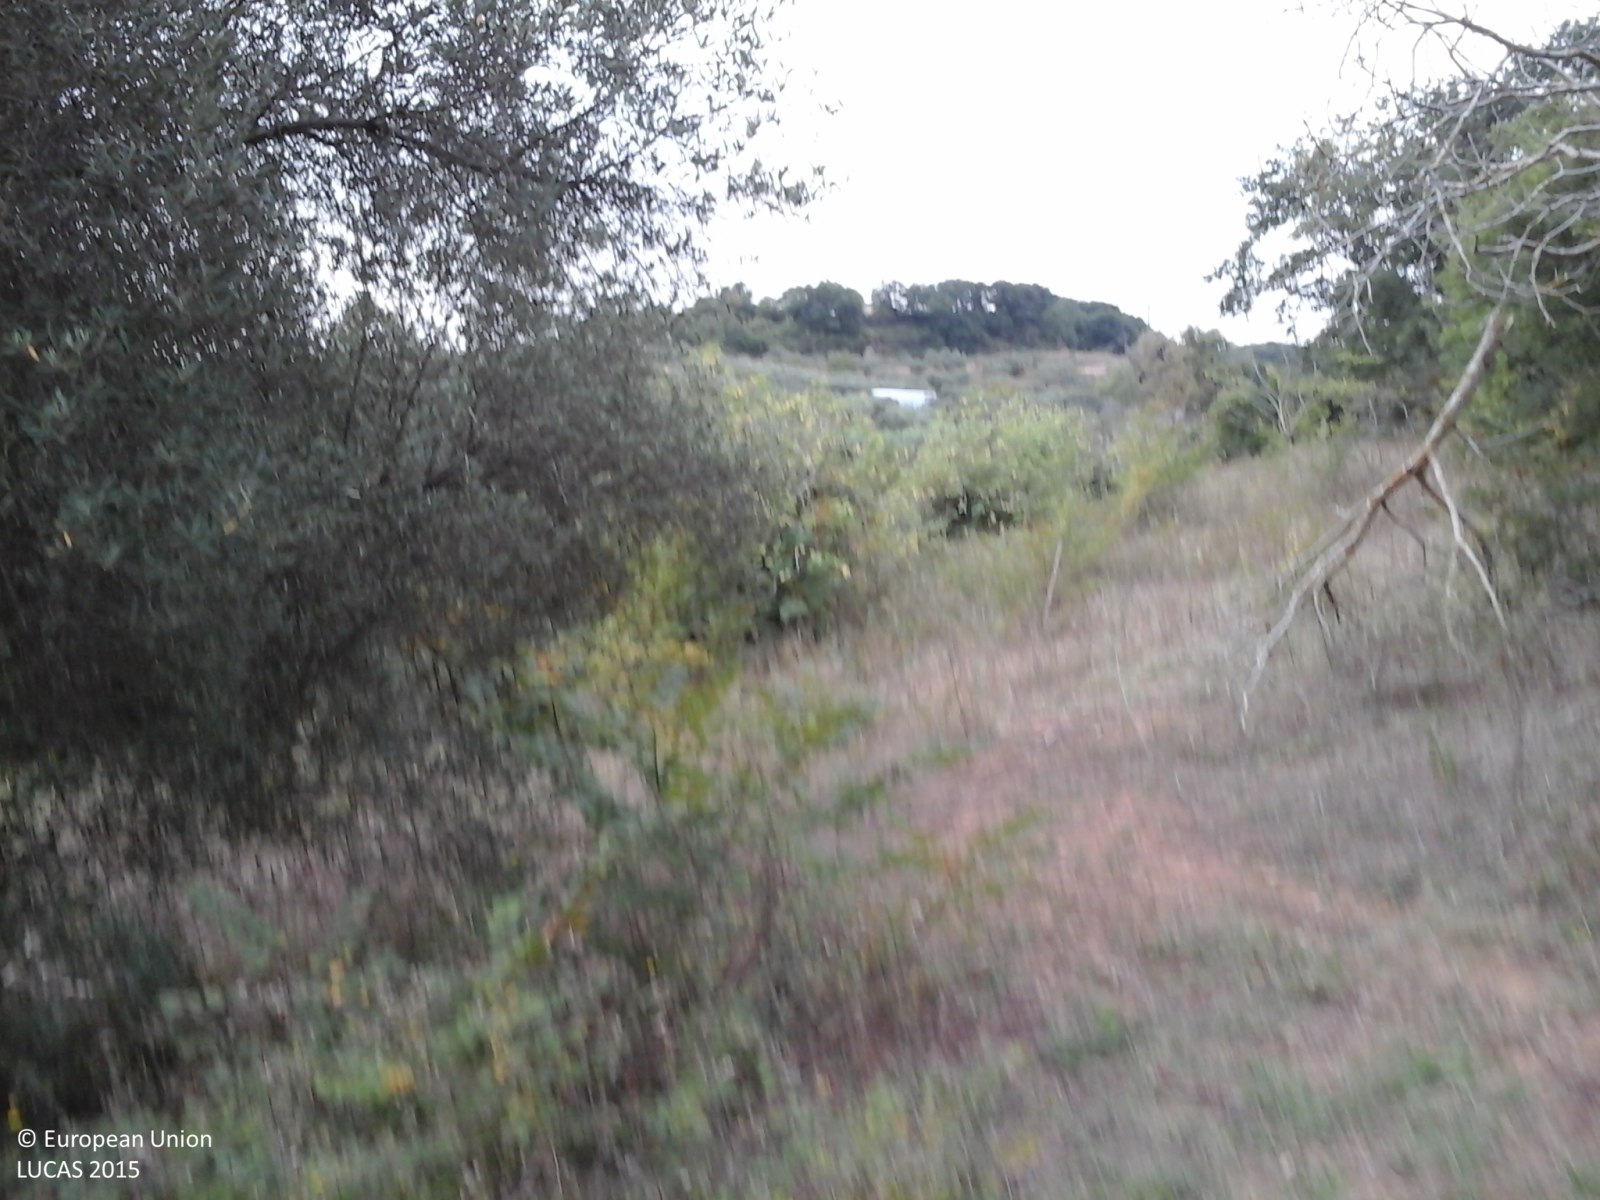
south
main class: Cropland
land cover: Apple fruit
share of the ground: > 75 %
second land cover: Spontaneously vegetated surfaces
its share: > 75 %
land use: Agriculture (excluding fallow land and kitchen gardens)
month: September
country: IT
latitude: 41.8520
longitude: 15.1754
